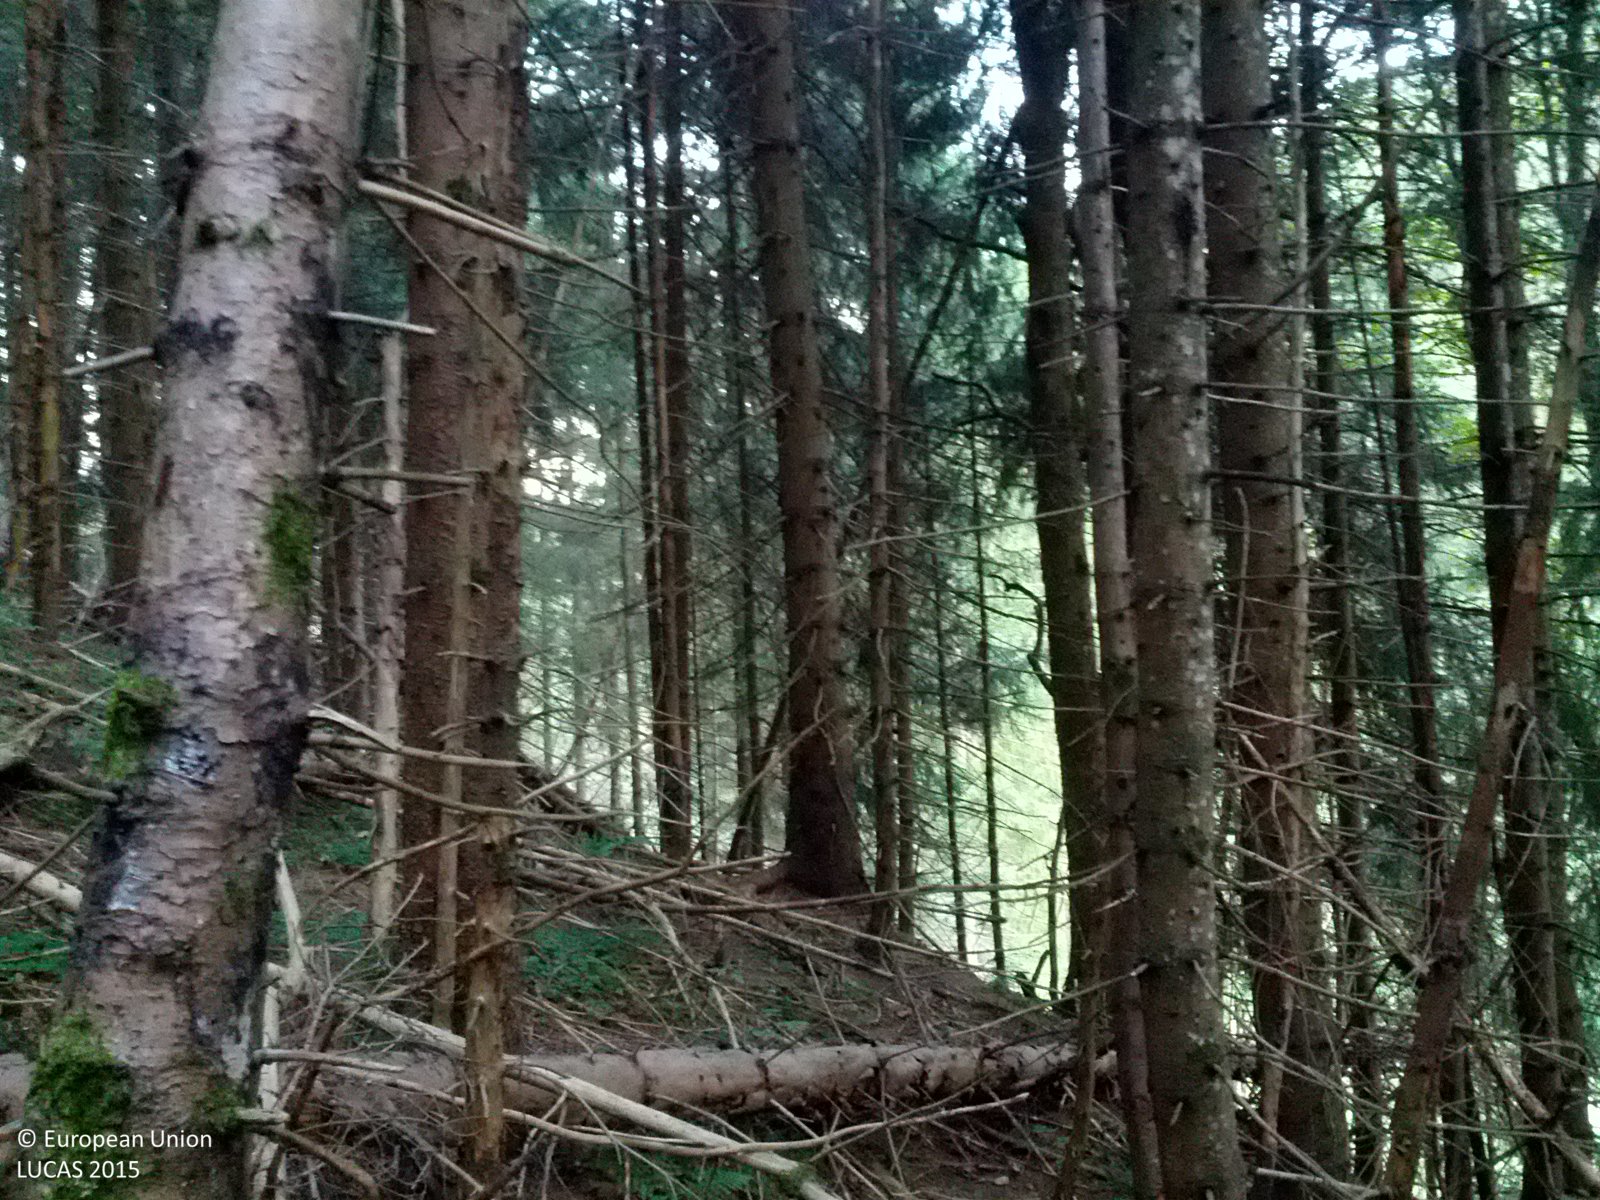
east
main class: Woodland
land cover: Spruce dominated coniferous woodland
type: alpine coniferous forest
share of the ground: > 75 %
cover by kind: coniferous forest trees 90 %, herbaceous plants 5 %, unconsolidated bare surface 5 %
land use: Forestry
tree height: > 5 m
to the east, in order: Spruce dominated coniferous woodland; Fences; Grassland without tree/shrub cover; Paved roads, cycling and walking lanes; Grass margins; Fences; Grassland without tree/shrub cover
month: September
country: AT
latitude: 47.4282
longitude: 13.5380
